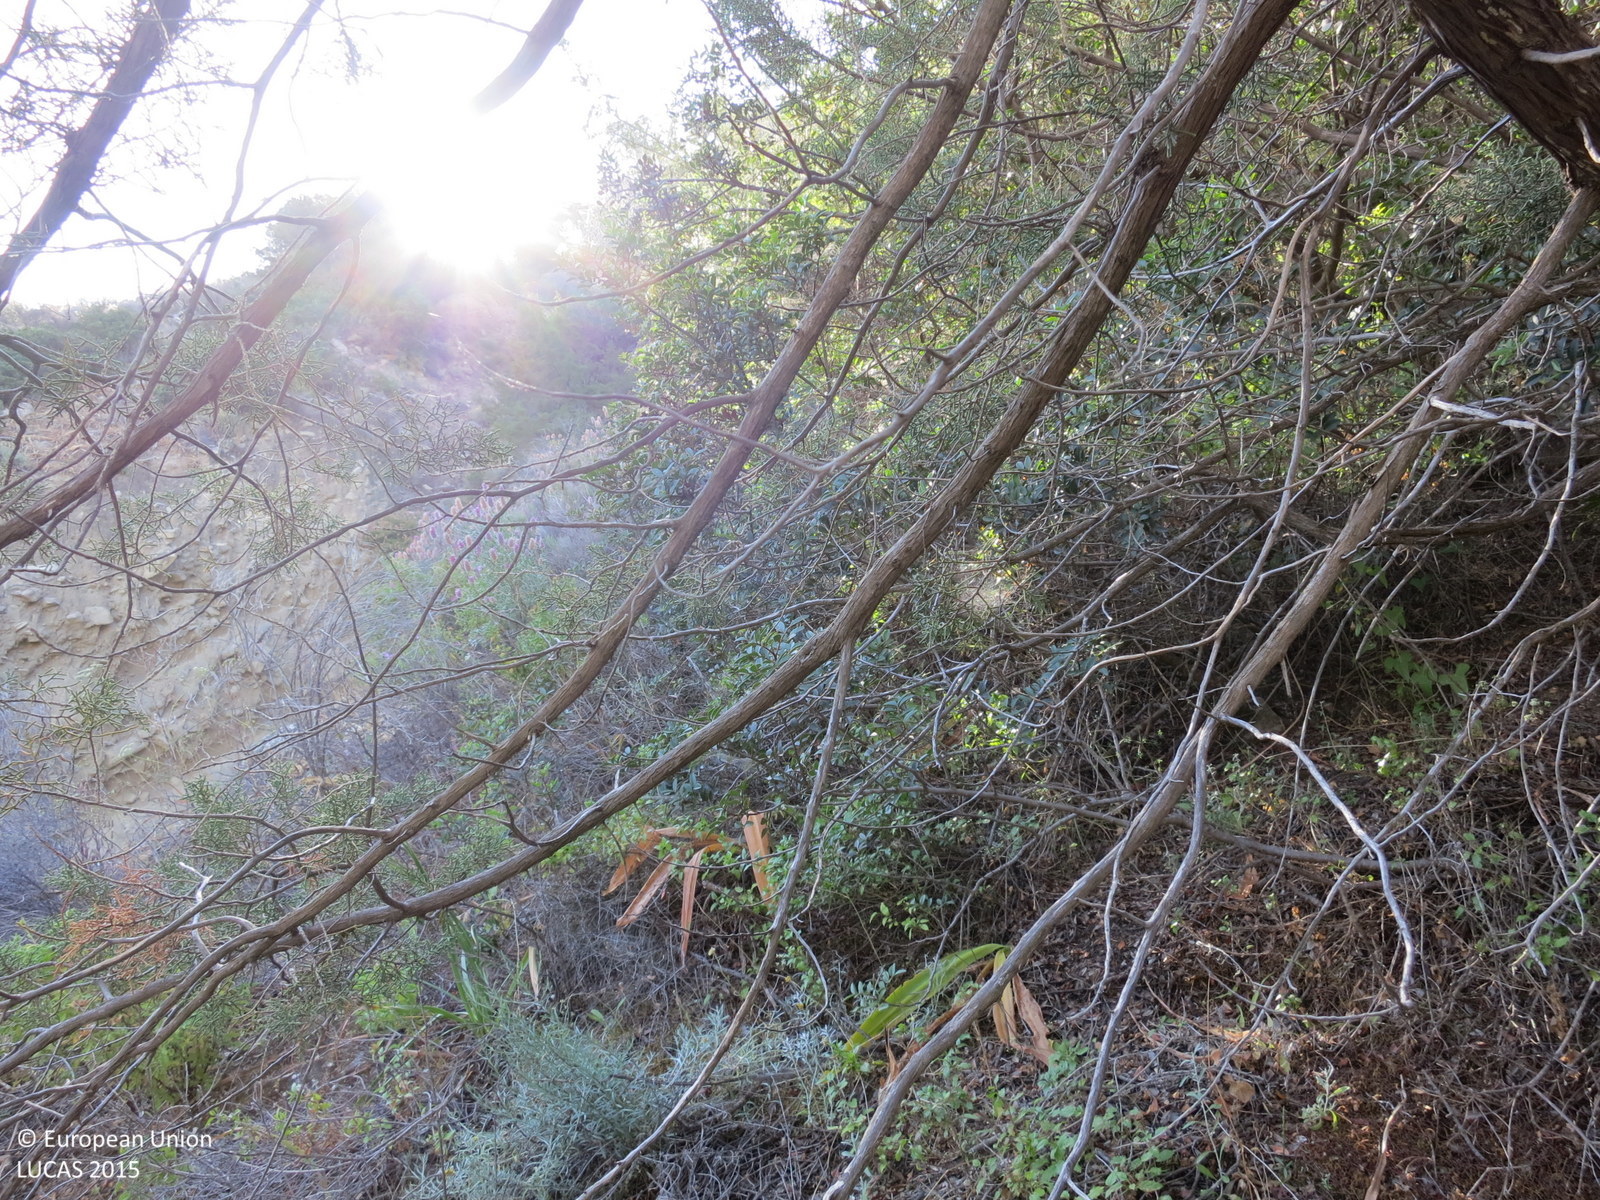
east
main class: Woodland
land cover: Pine dominated mixed woodland
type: coniferous forest of the mediterranean region
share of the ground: > 75 %
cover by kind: coniferous forest trees 50 %, broadleaved forest trees 25 %, shrubs 10 %, herbaceous plants 5 %
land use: Semi-natural and natural areas not in use
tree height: > 5 m
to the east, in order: Pine dominated mixed woodland; Rivers and streams; Pine dominated mixed woodland; Rock outcrops; Shrubland without tree cover; Shrubland with sparse tree cover; Tracks
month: June
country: GR
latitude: 34.9940
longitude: 25.4929
